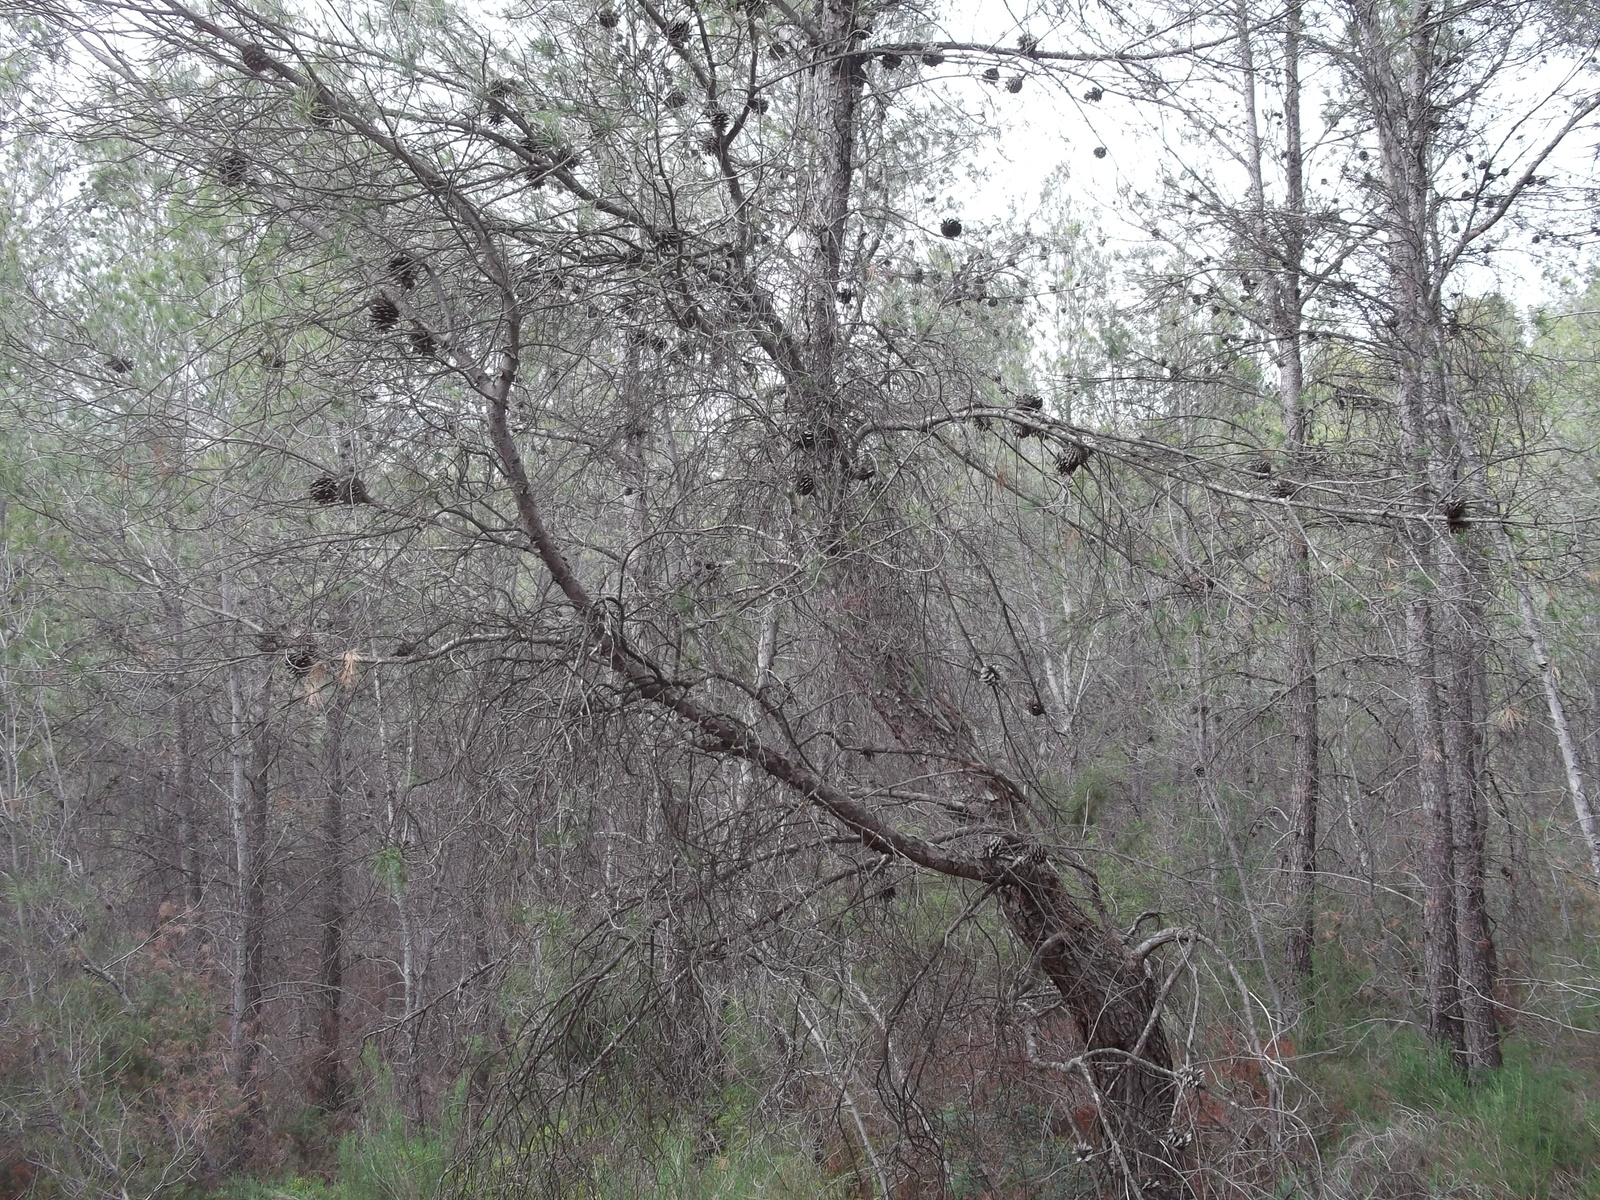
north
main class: Woodland
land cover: Pine dominated coniferous woodland
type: coniferous forest of the mediterranean region
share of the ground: 25 - 50 %
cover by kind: shrubs 60 %, coniferous forest trees 40 %
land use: Forestry
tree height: > 5 m
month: April
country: ES
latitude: 37.9370
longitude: -1.5570
